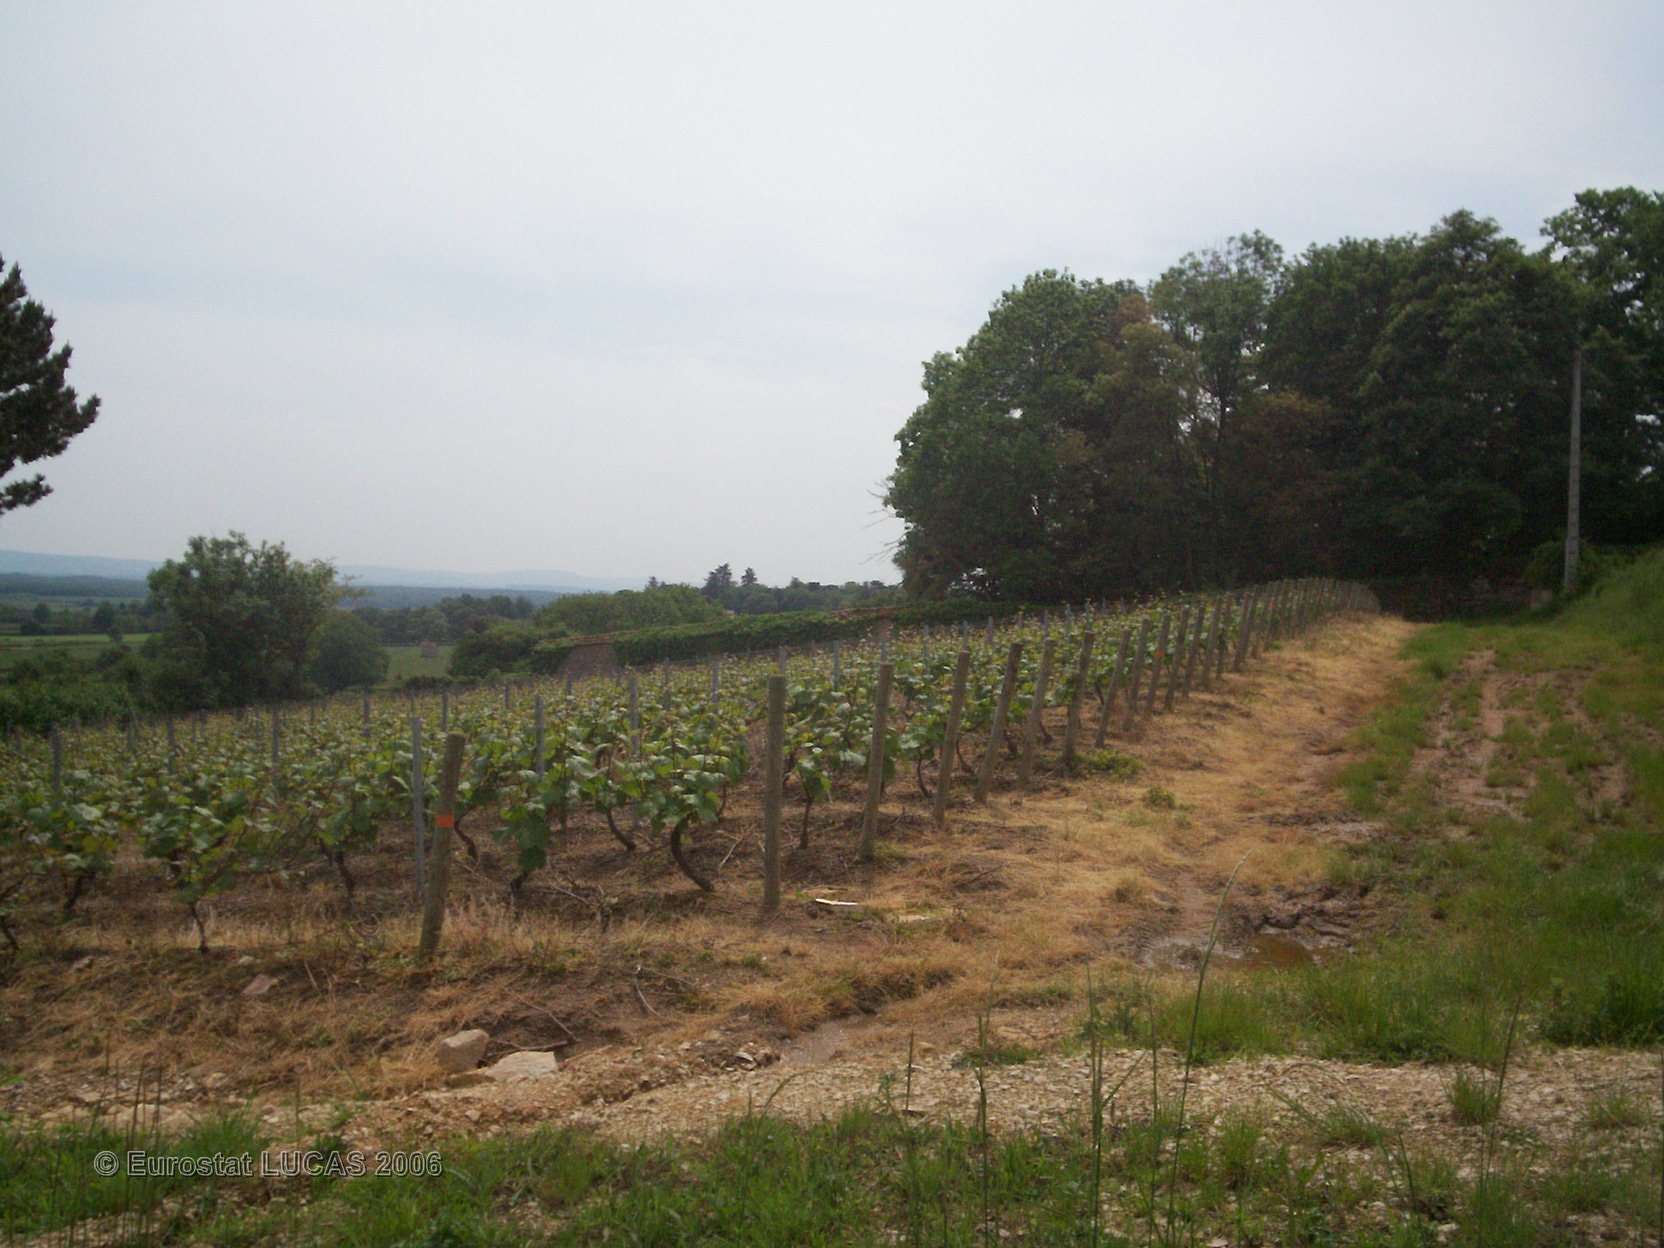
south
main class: Cropland
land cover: Apple fruit
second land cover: Grassland with sparse tree/shrub cover
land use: Kitchen garden
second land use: Residential
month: May
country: FR
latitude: 46.7253
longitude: 4.7020
